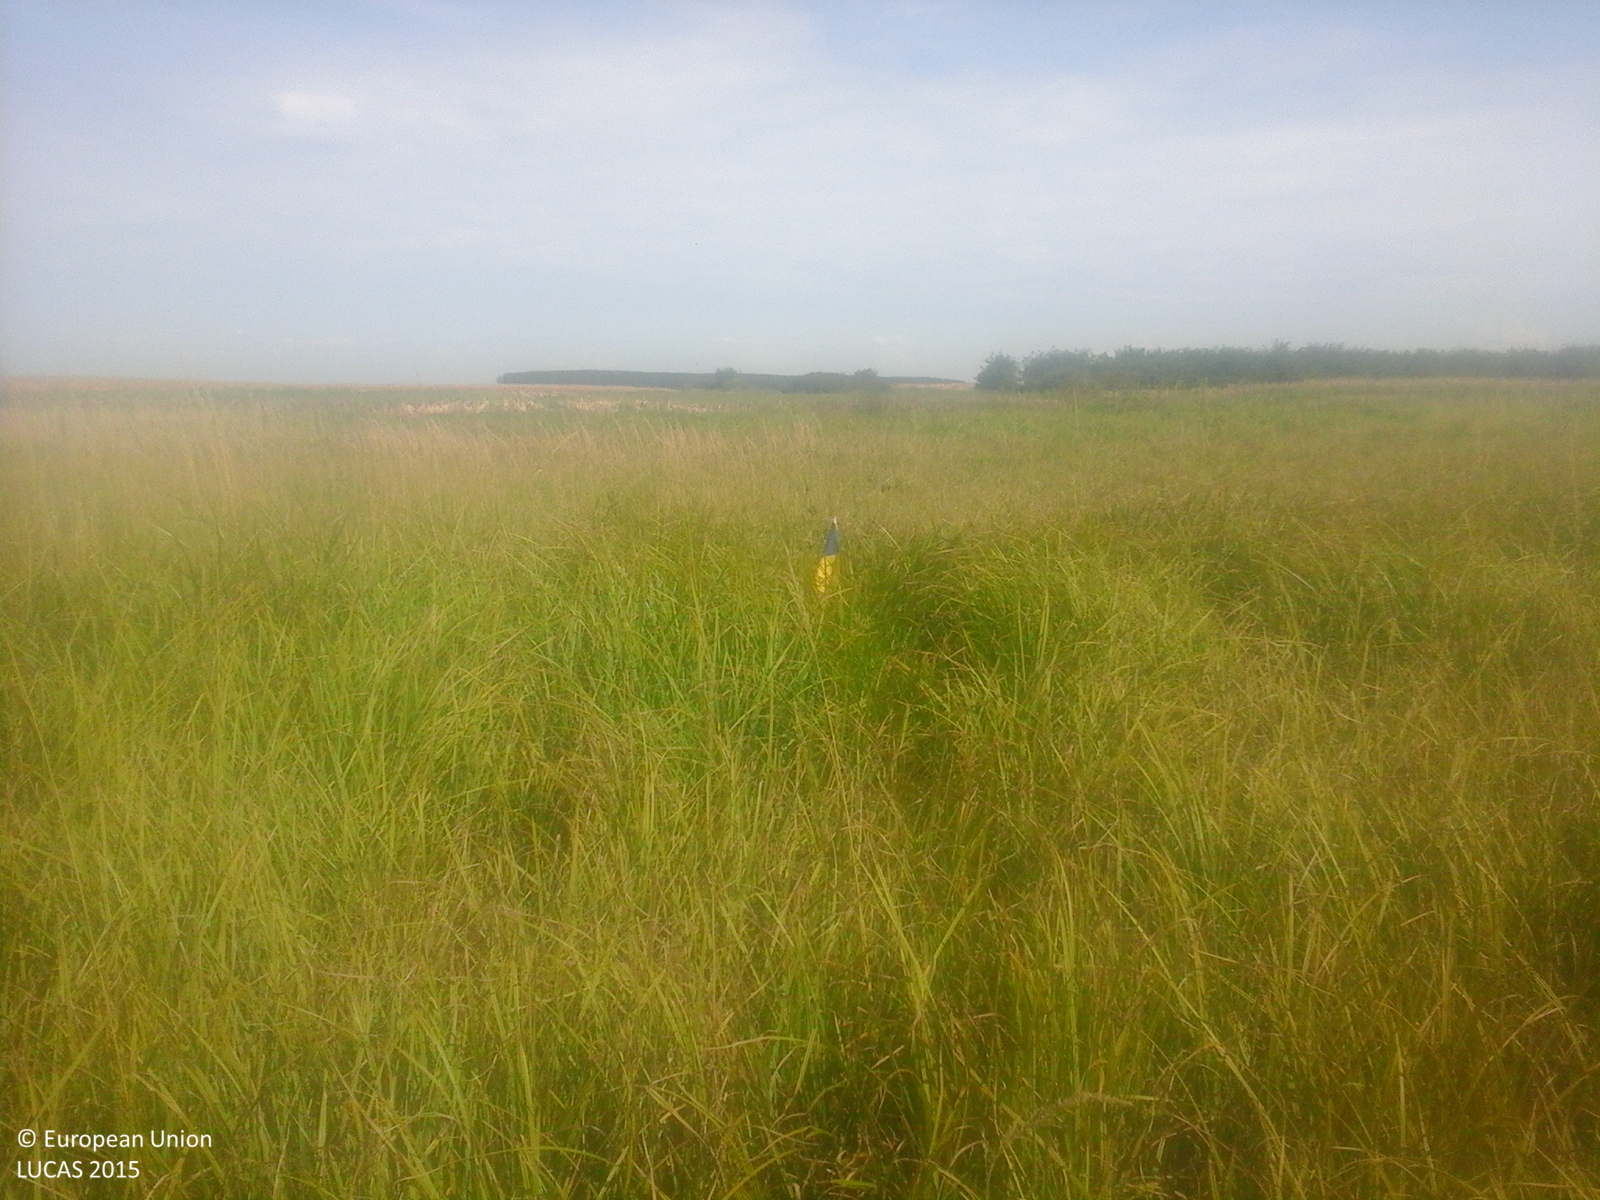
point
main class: Grassland
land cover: Spontaneously vegetated surfaces
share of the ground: > 75 %
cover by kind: herbaceous plants 100 %
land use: Fallow land
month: September
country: RO
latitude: 47.7538
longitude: 22.5854
